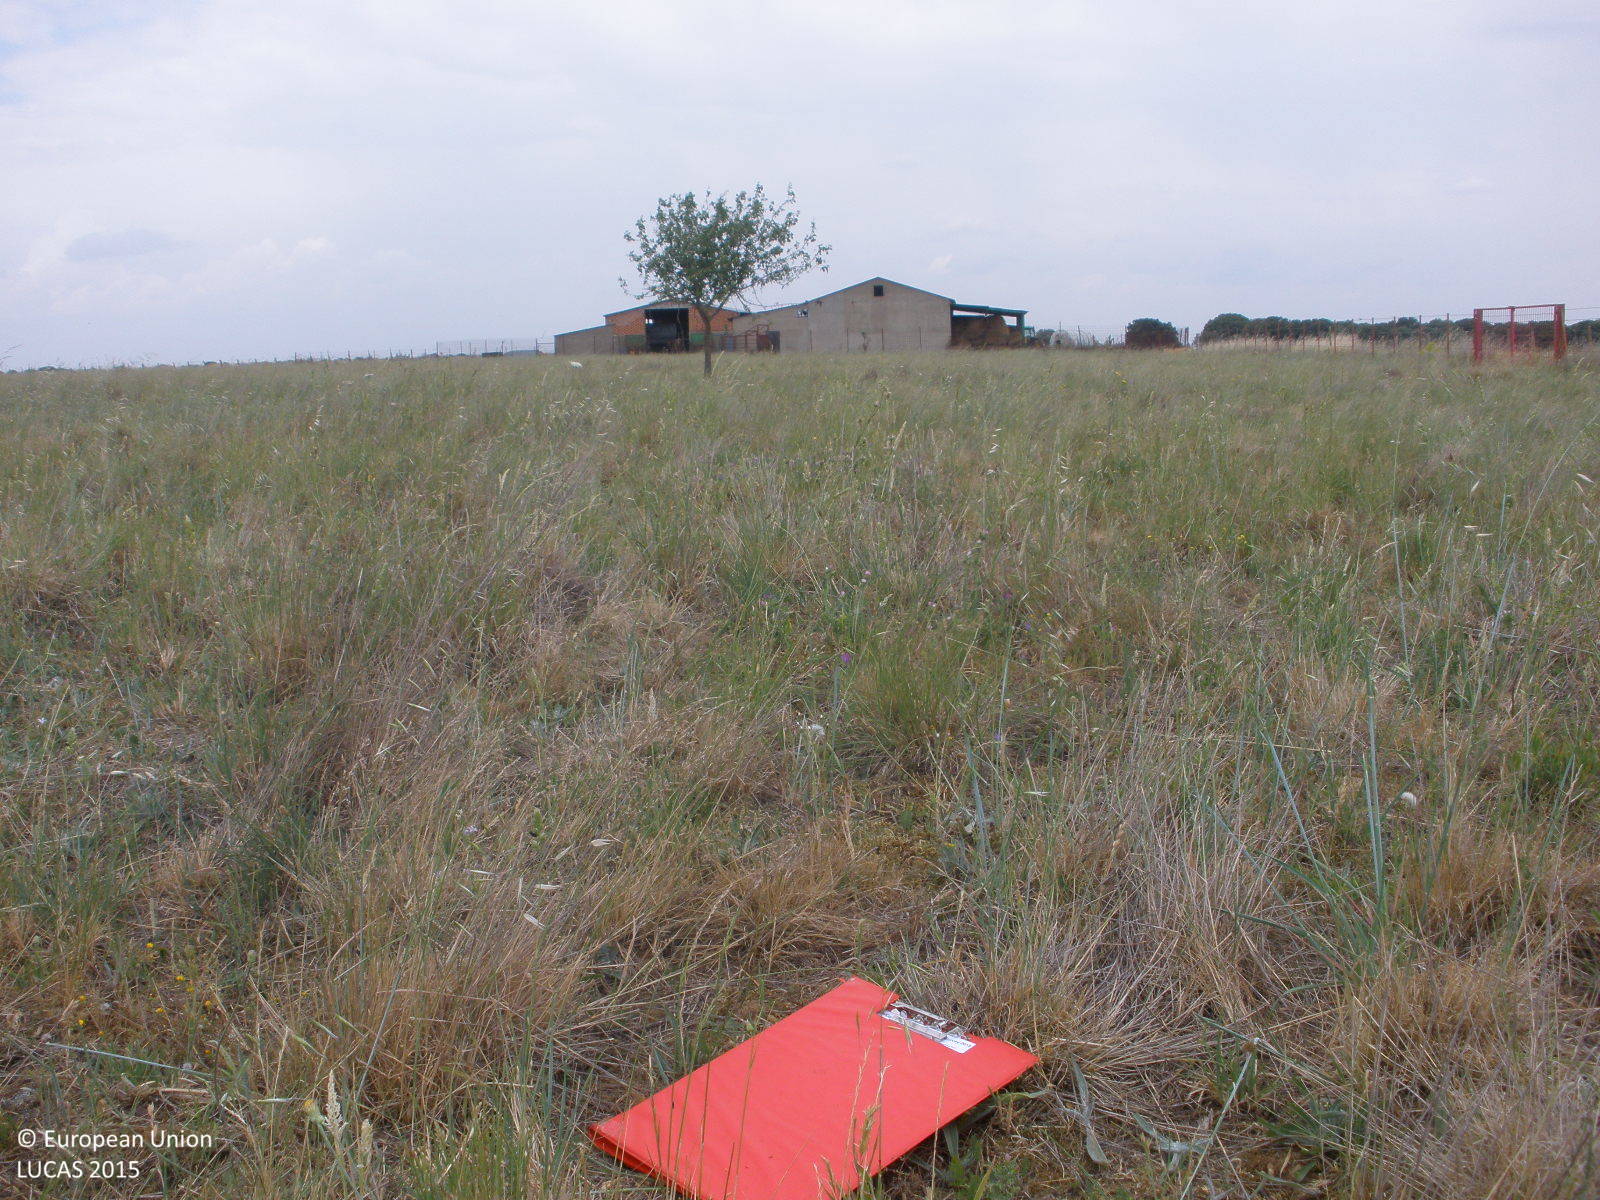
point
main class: Grassland
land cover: Grassland without tree/shrub cover
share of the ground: > 75 %
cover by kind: herbaceous plants 100 %
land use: Agriculture (excluding fallow land and kitchen gardens)
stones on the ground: 25 - 50 %
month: June
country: ES
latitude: 40.6739
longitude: -6.1121
